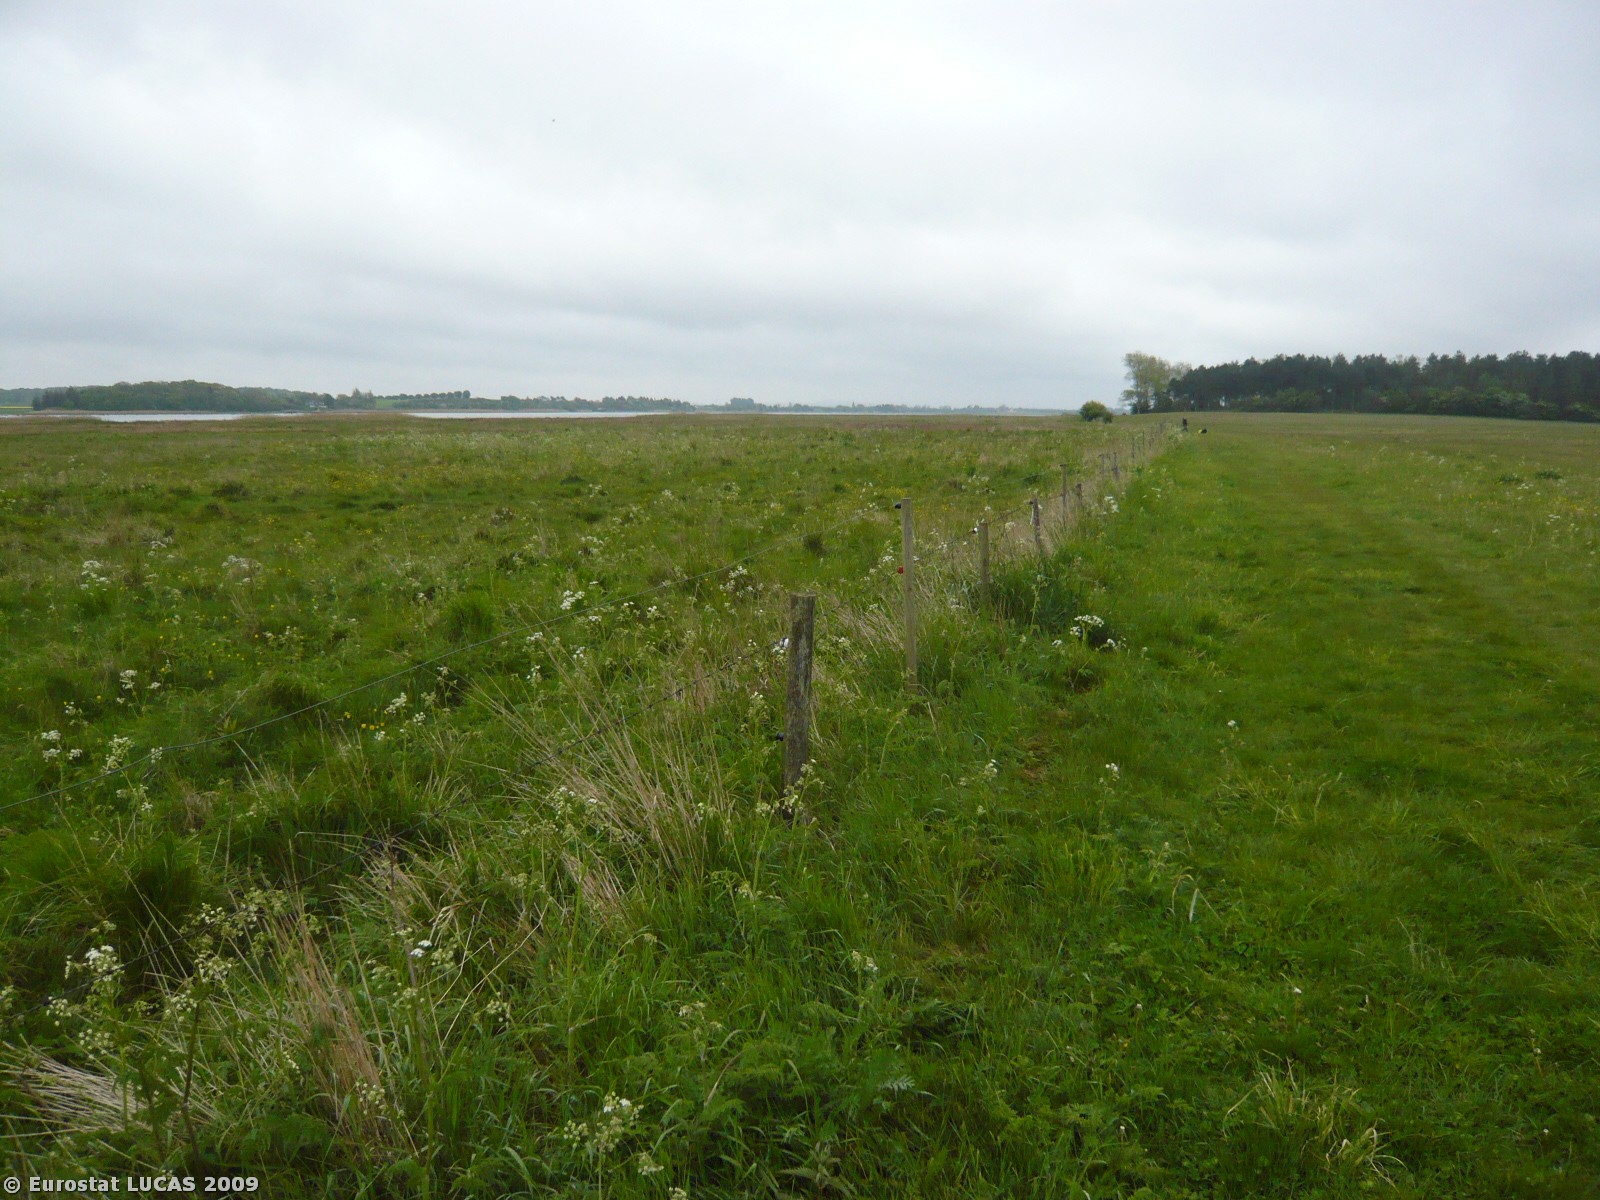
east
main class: Grassland
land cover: Grassland without tree/shrub cover
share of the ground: > 75 %
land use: Agriculture (excluding fallow land and kitchen gardens)
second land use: Nature reserves
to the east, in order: Grassland without tree/shrub cover; Inland running water; Salt marshes; Fences; Bare land; Transitional water bodies
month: May
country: DK
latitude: 55.0789
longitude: 11.7687
